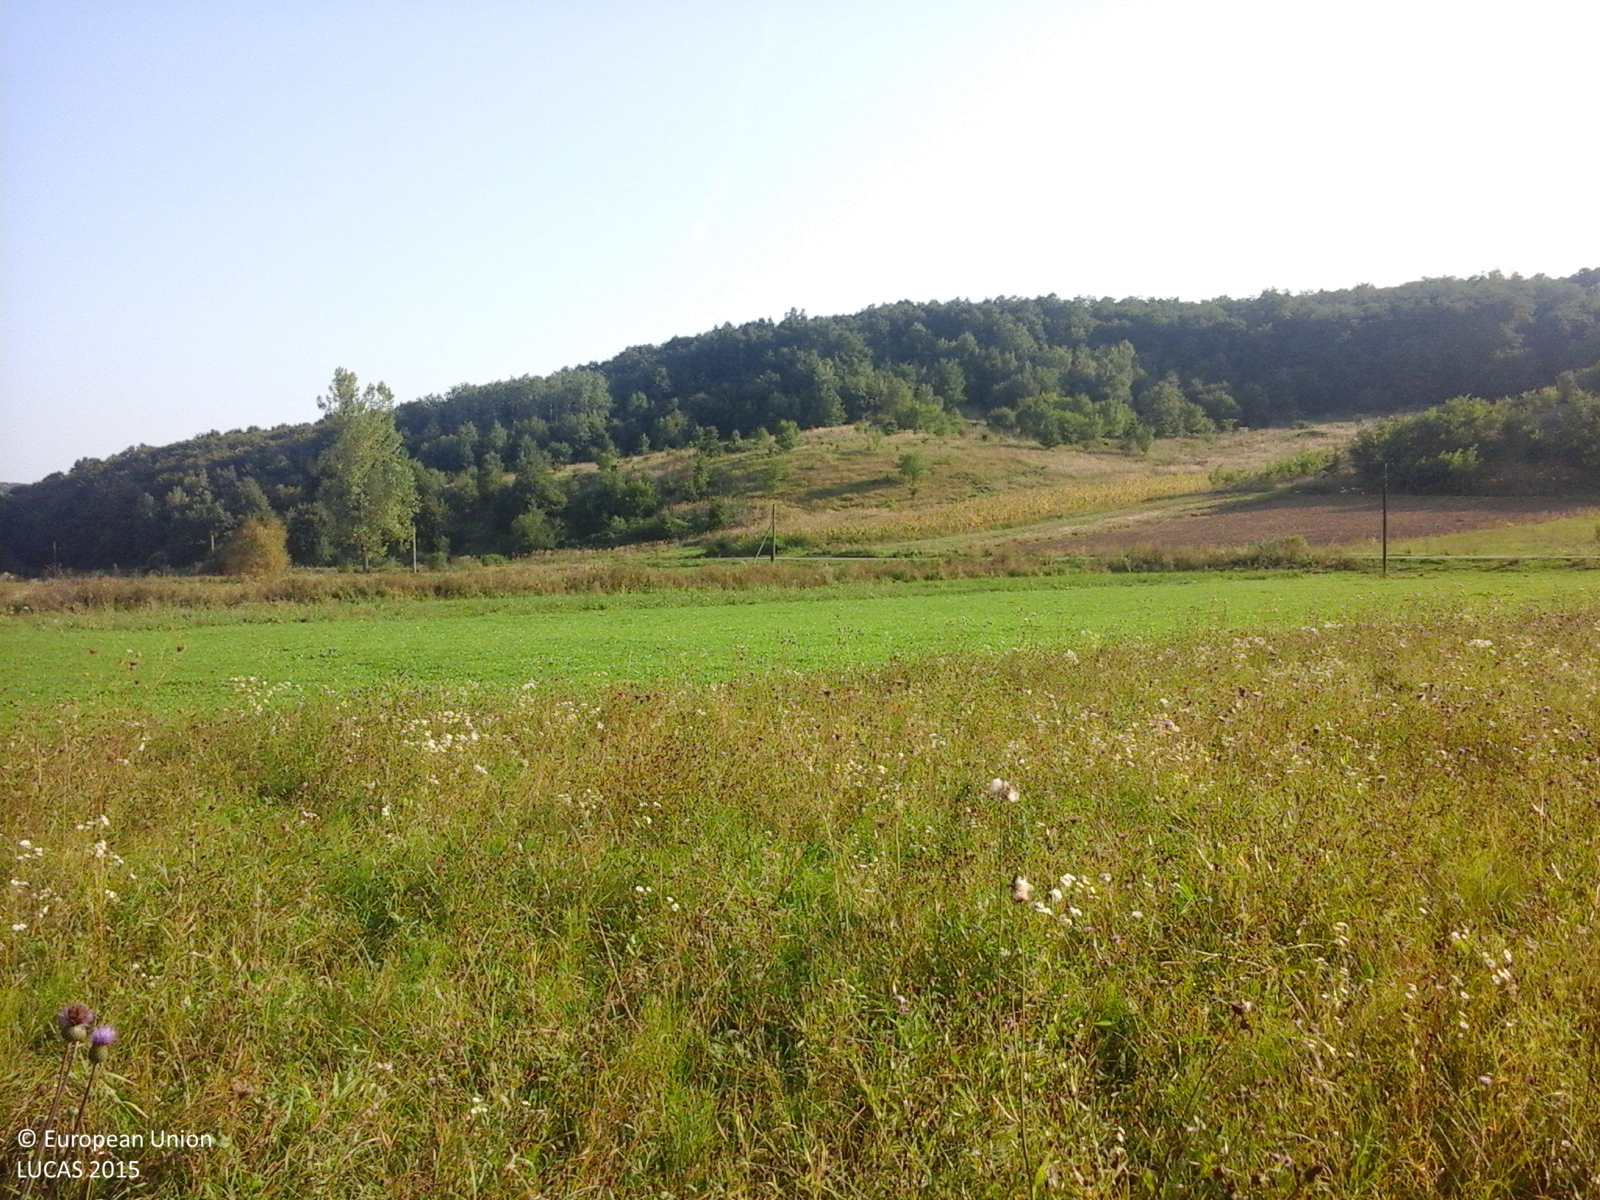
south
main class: Grassland
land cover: Spontaneously vegetated surfaces
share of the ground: > 75 %
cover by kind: herbaceous plants 100 %
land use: Fallow land
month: September
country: RO
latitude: 47.2275
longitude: 22.7248
